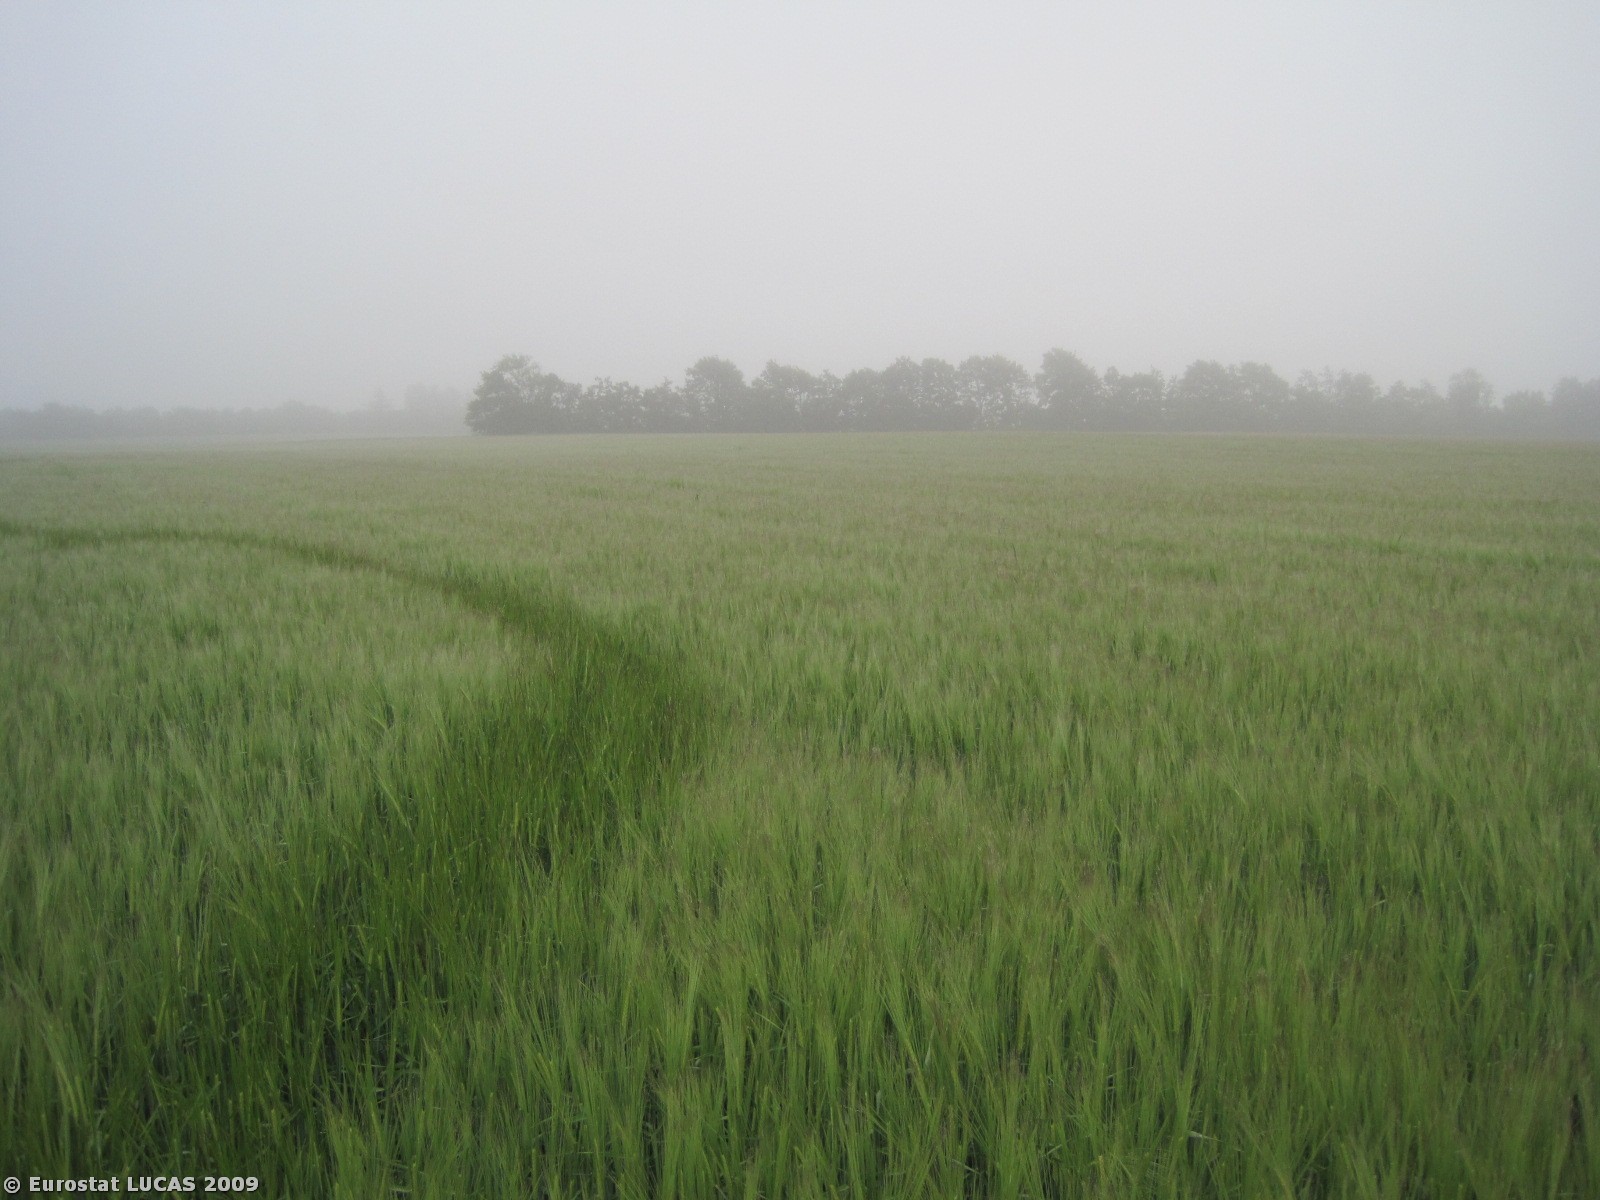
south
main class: Cropland
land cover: Barley
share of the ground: > 75 %
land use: Agriculture (excluding fallow land and kitchen gardens)
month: June
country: DK
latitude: 56.4893
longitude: 8.9781
